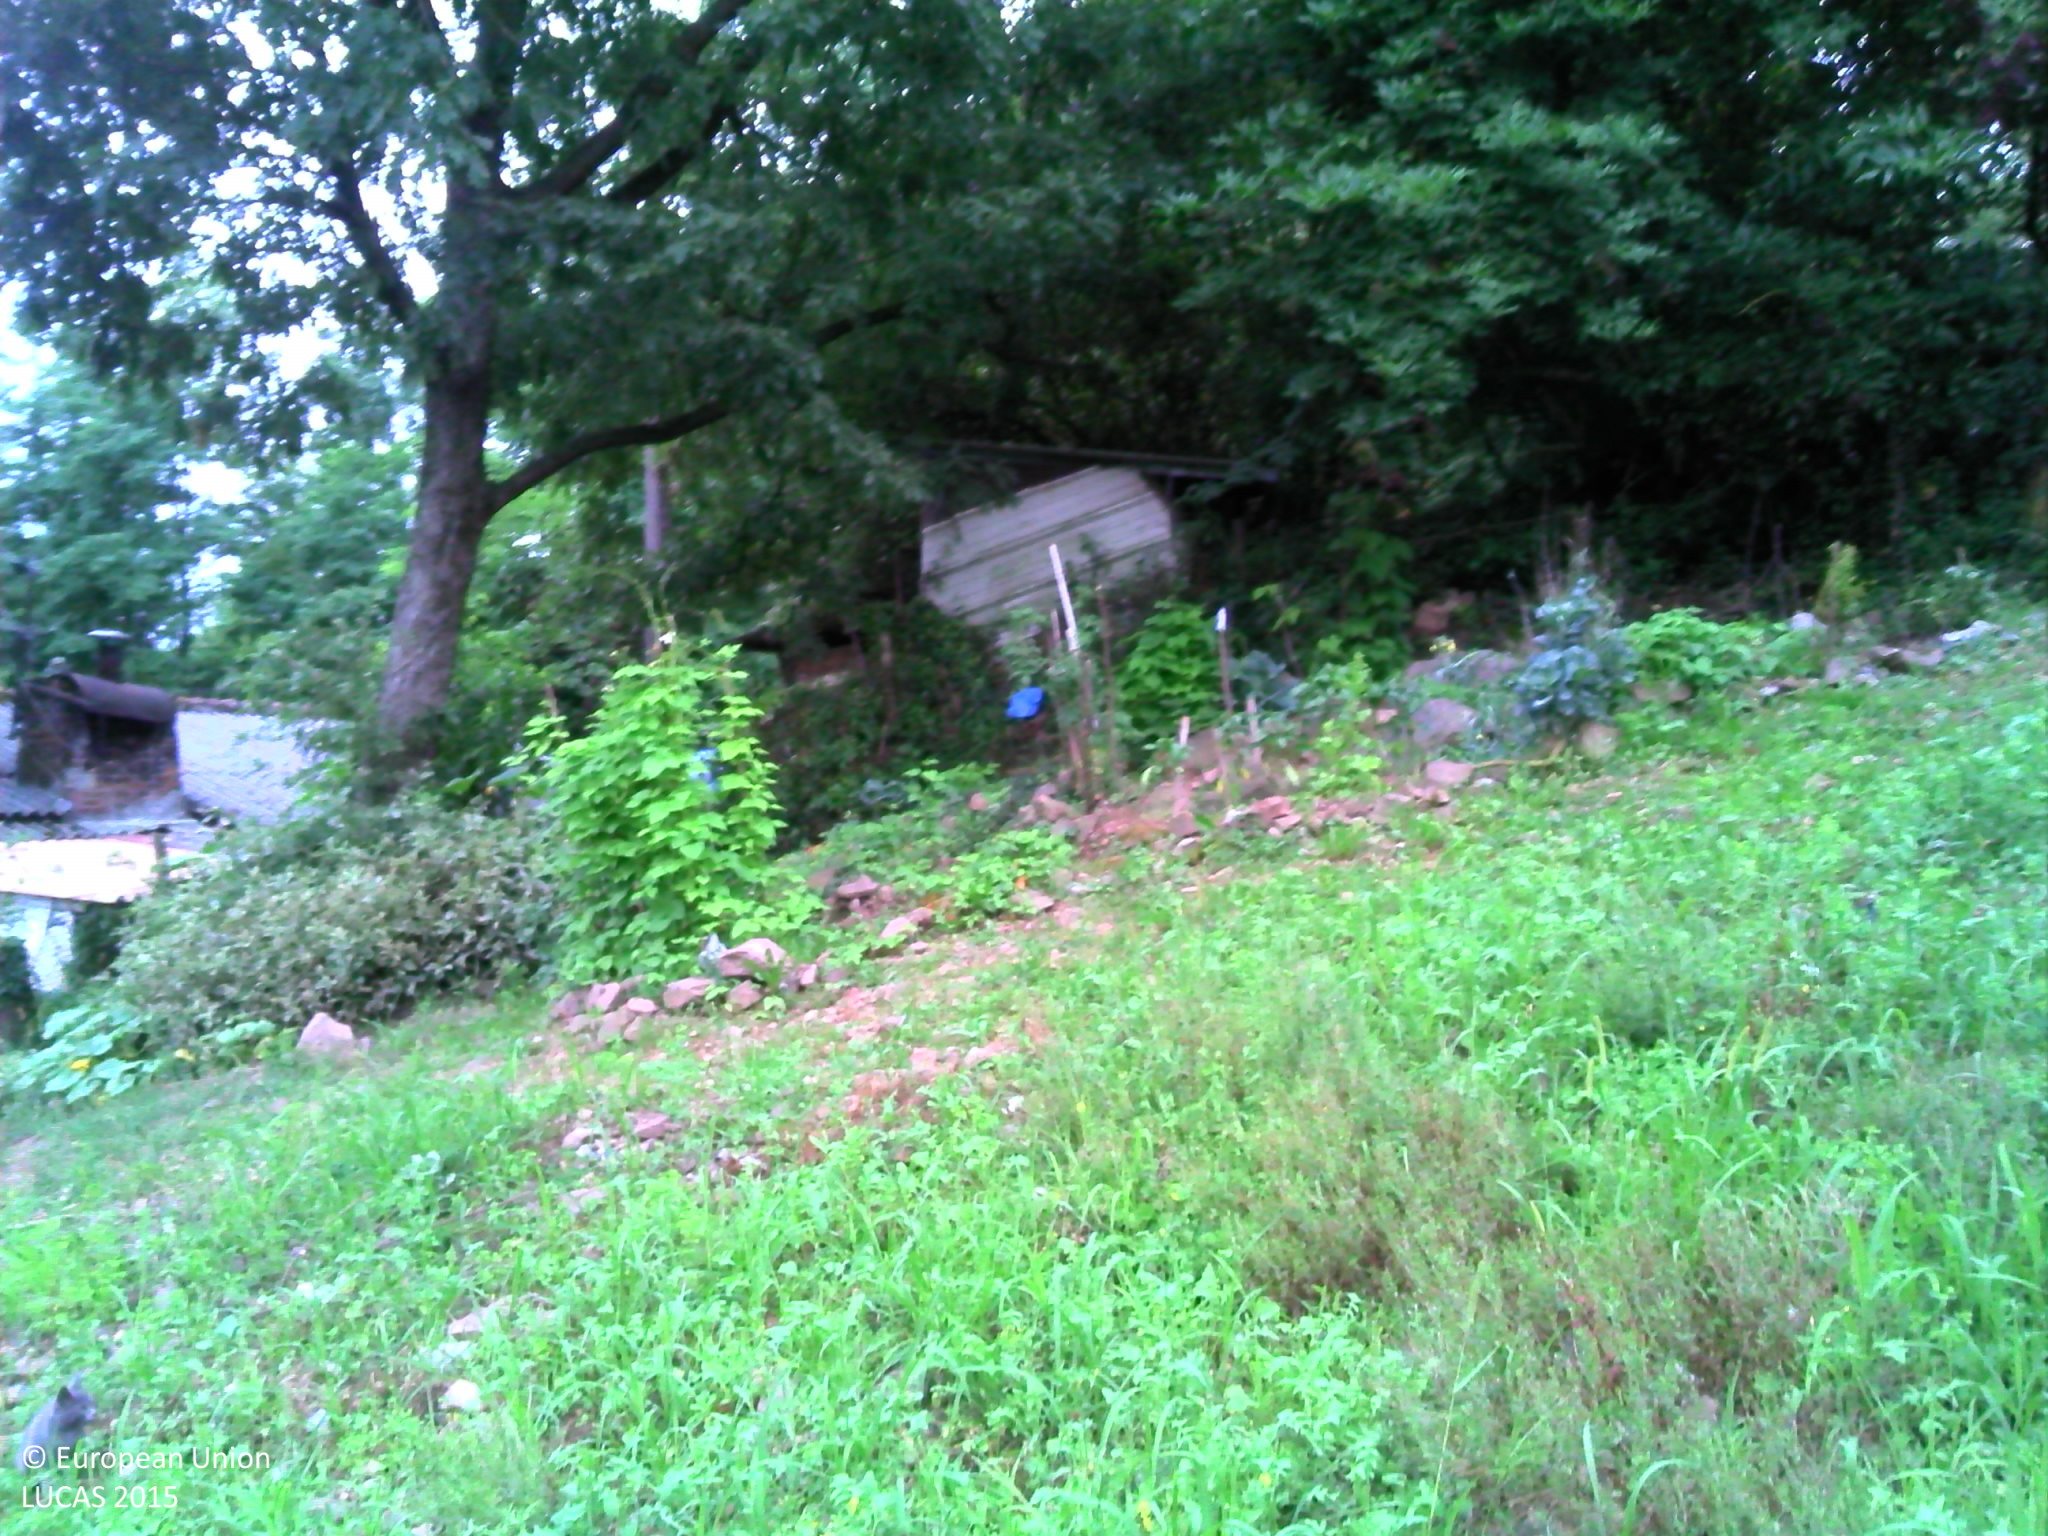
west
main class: Shrubland
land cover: Shrubland with sparse tree cover
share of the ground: > 75 %
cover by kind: shrubs 80 %, herbaceous plants 15 %, broadleaved forest trees 5 %
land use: Semi-natural and natural areas not in use
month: August
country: FR
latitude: 43.1731
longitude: -1.2446
